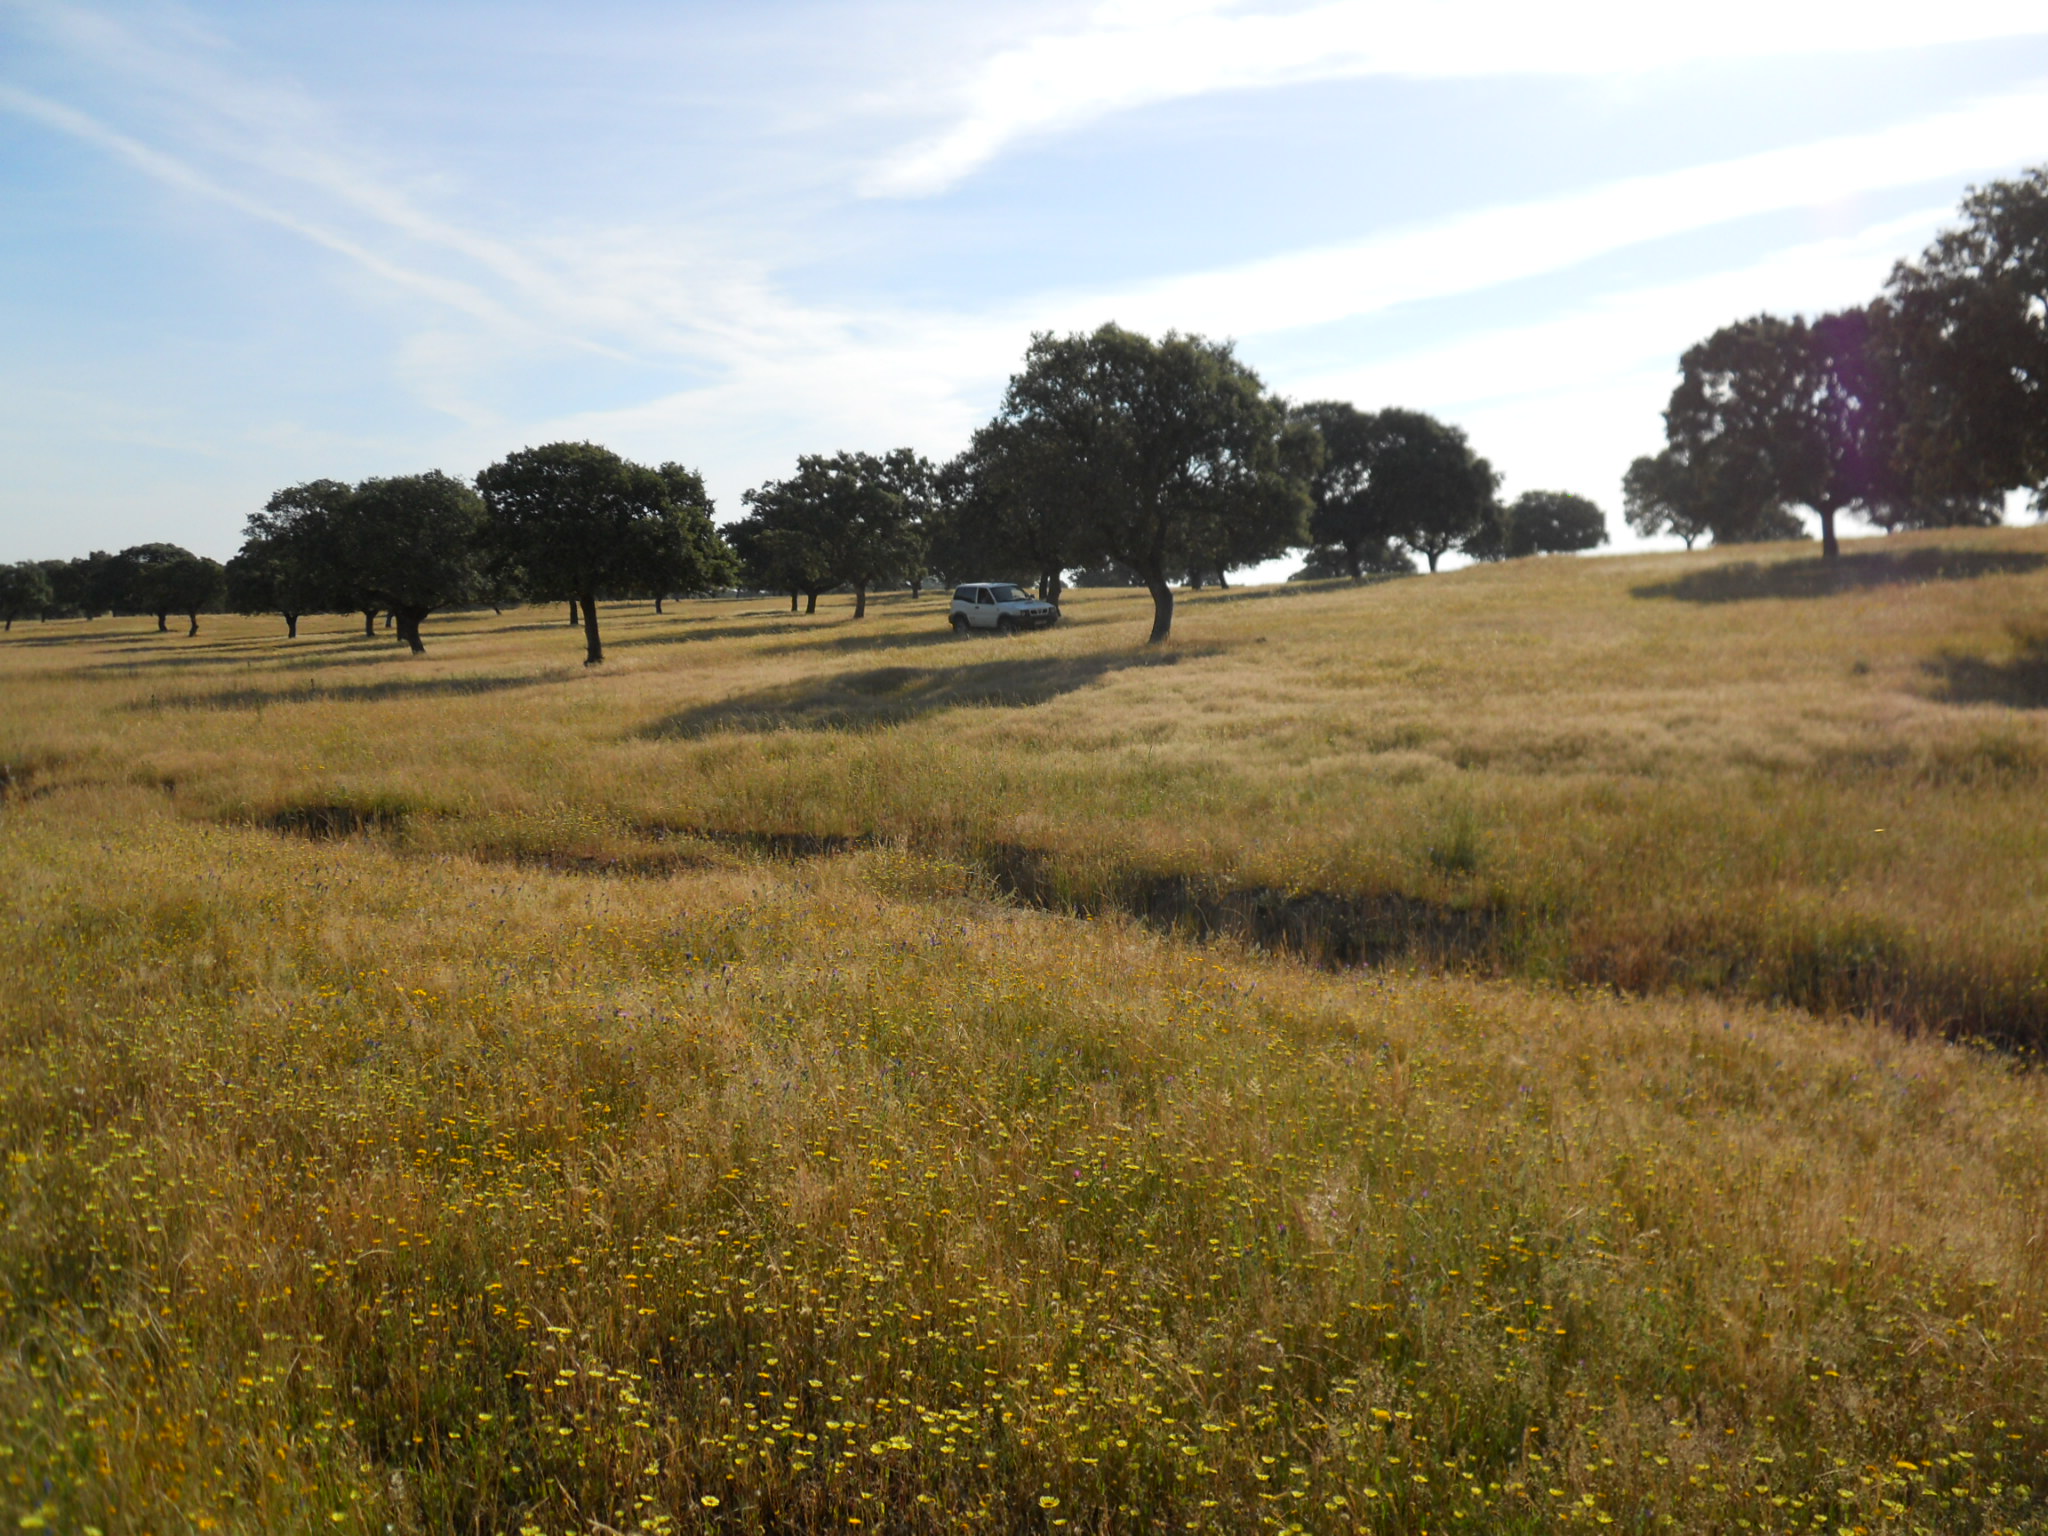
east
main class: Woodland
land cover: Broadleaved woodland
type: broadleaved evergreen forest
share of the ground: > 75 %
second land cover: Grassland without tree/shrub cover
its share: 50 - 75 %
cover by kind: broadleaved forest trees 90 %, herbaceous plants 10 %
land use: Forestry
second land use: Agriculture (excluding fallow land and kitchen gardens)
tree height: > 5 m
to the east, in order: Broadleaved woodland; Grassland without tree/shrub cover; Rivers and streams; Broadleaved woodland; Tracks; Broadleaved woodland
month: May
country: ES
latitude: 39.2467
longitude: -6.3905
